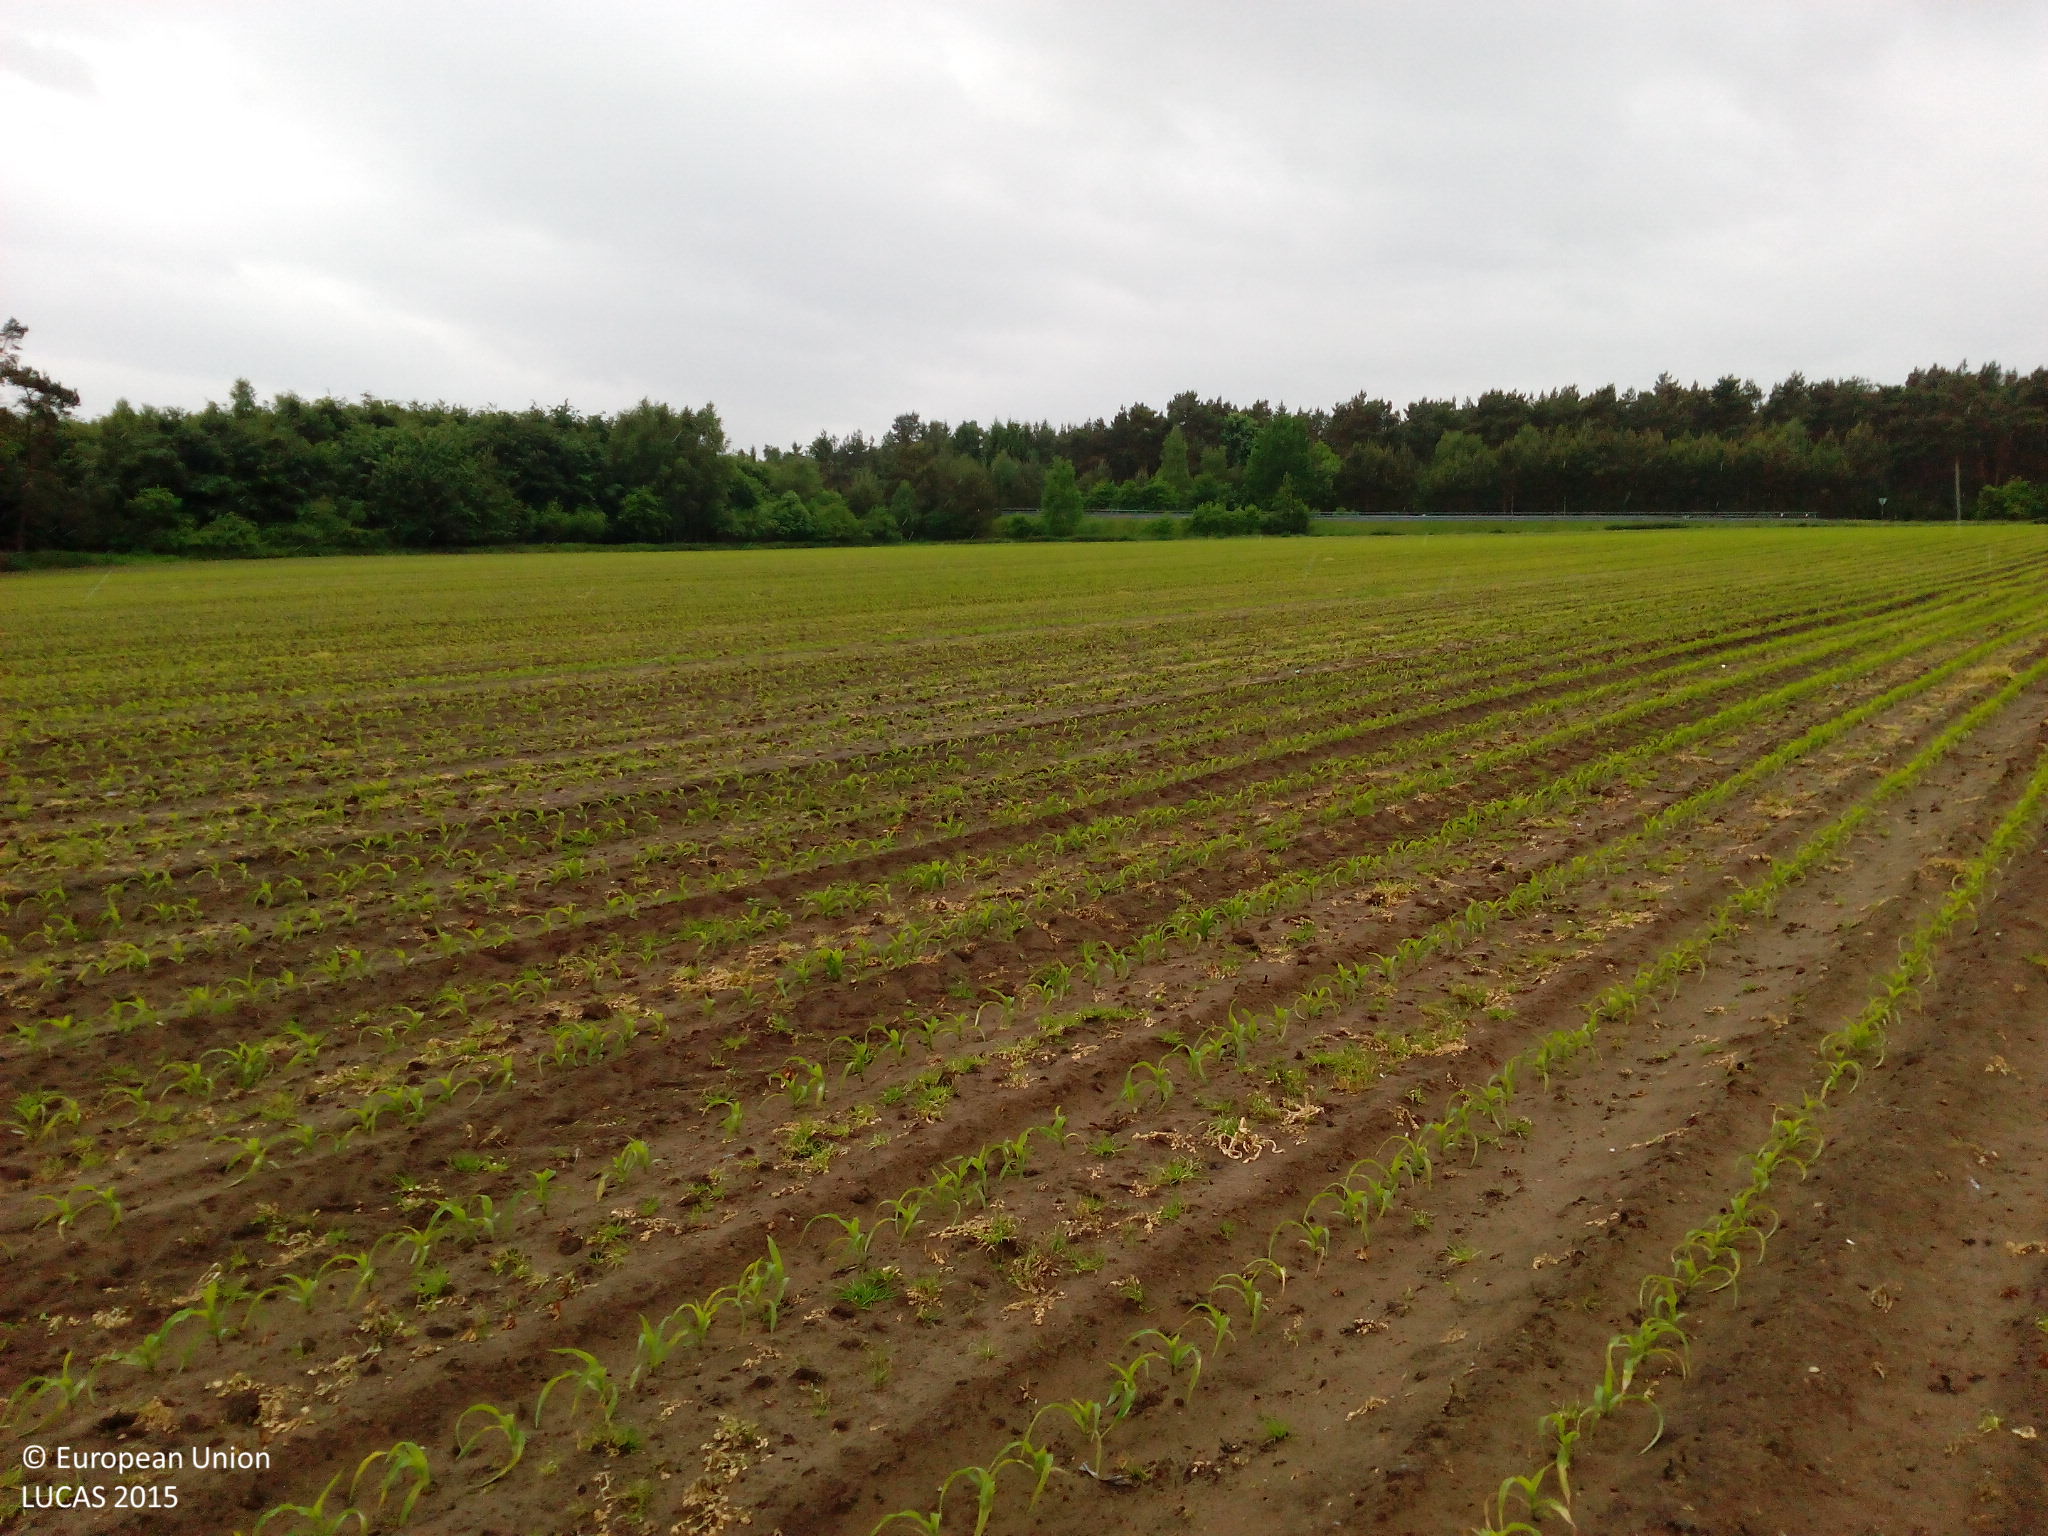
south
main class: Cropland
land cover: Maize
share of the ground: > 75 %
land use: Agriculture (excluding fallow land and kitchen gardens)
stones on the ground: < 10 %
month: June
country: DE
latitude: 52.3484
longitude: 7.3726
